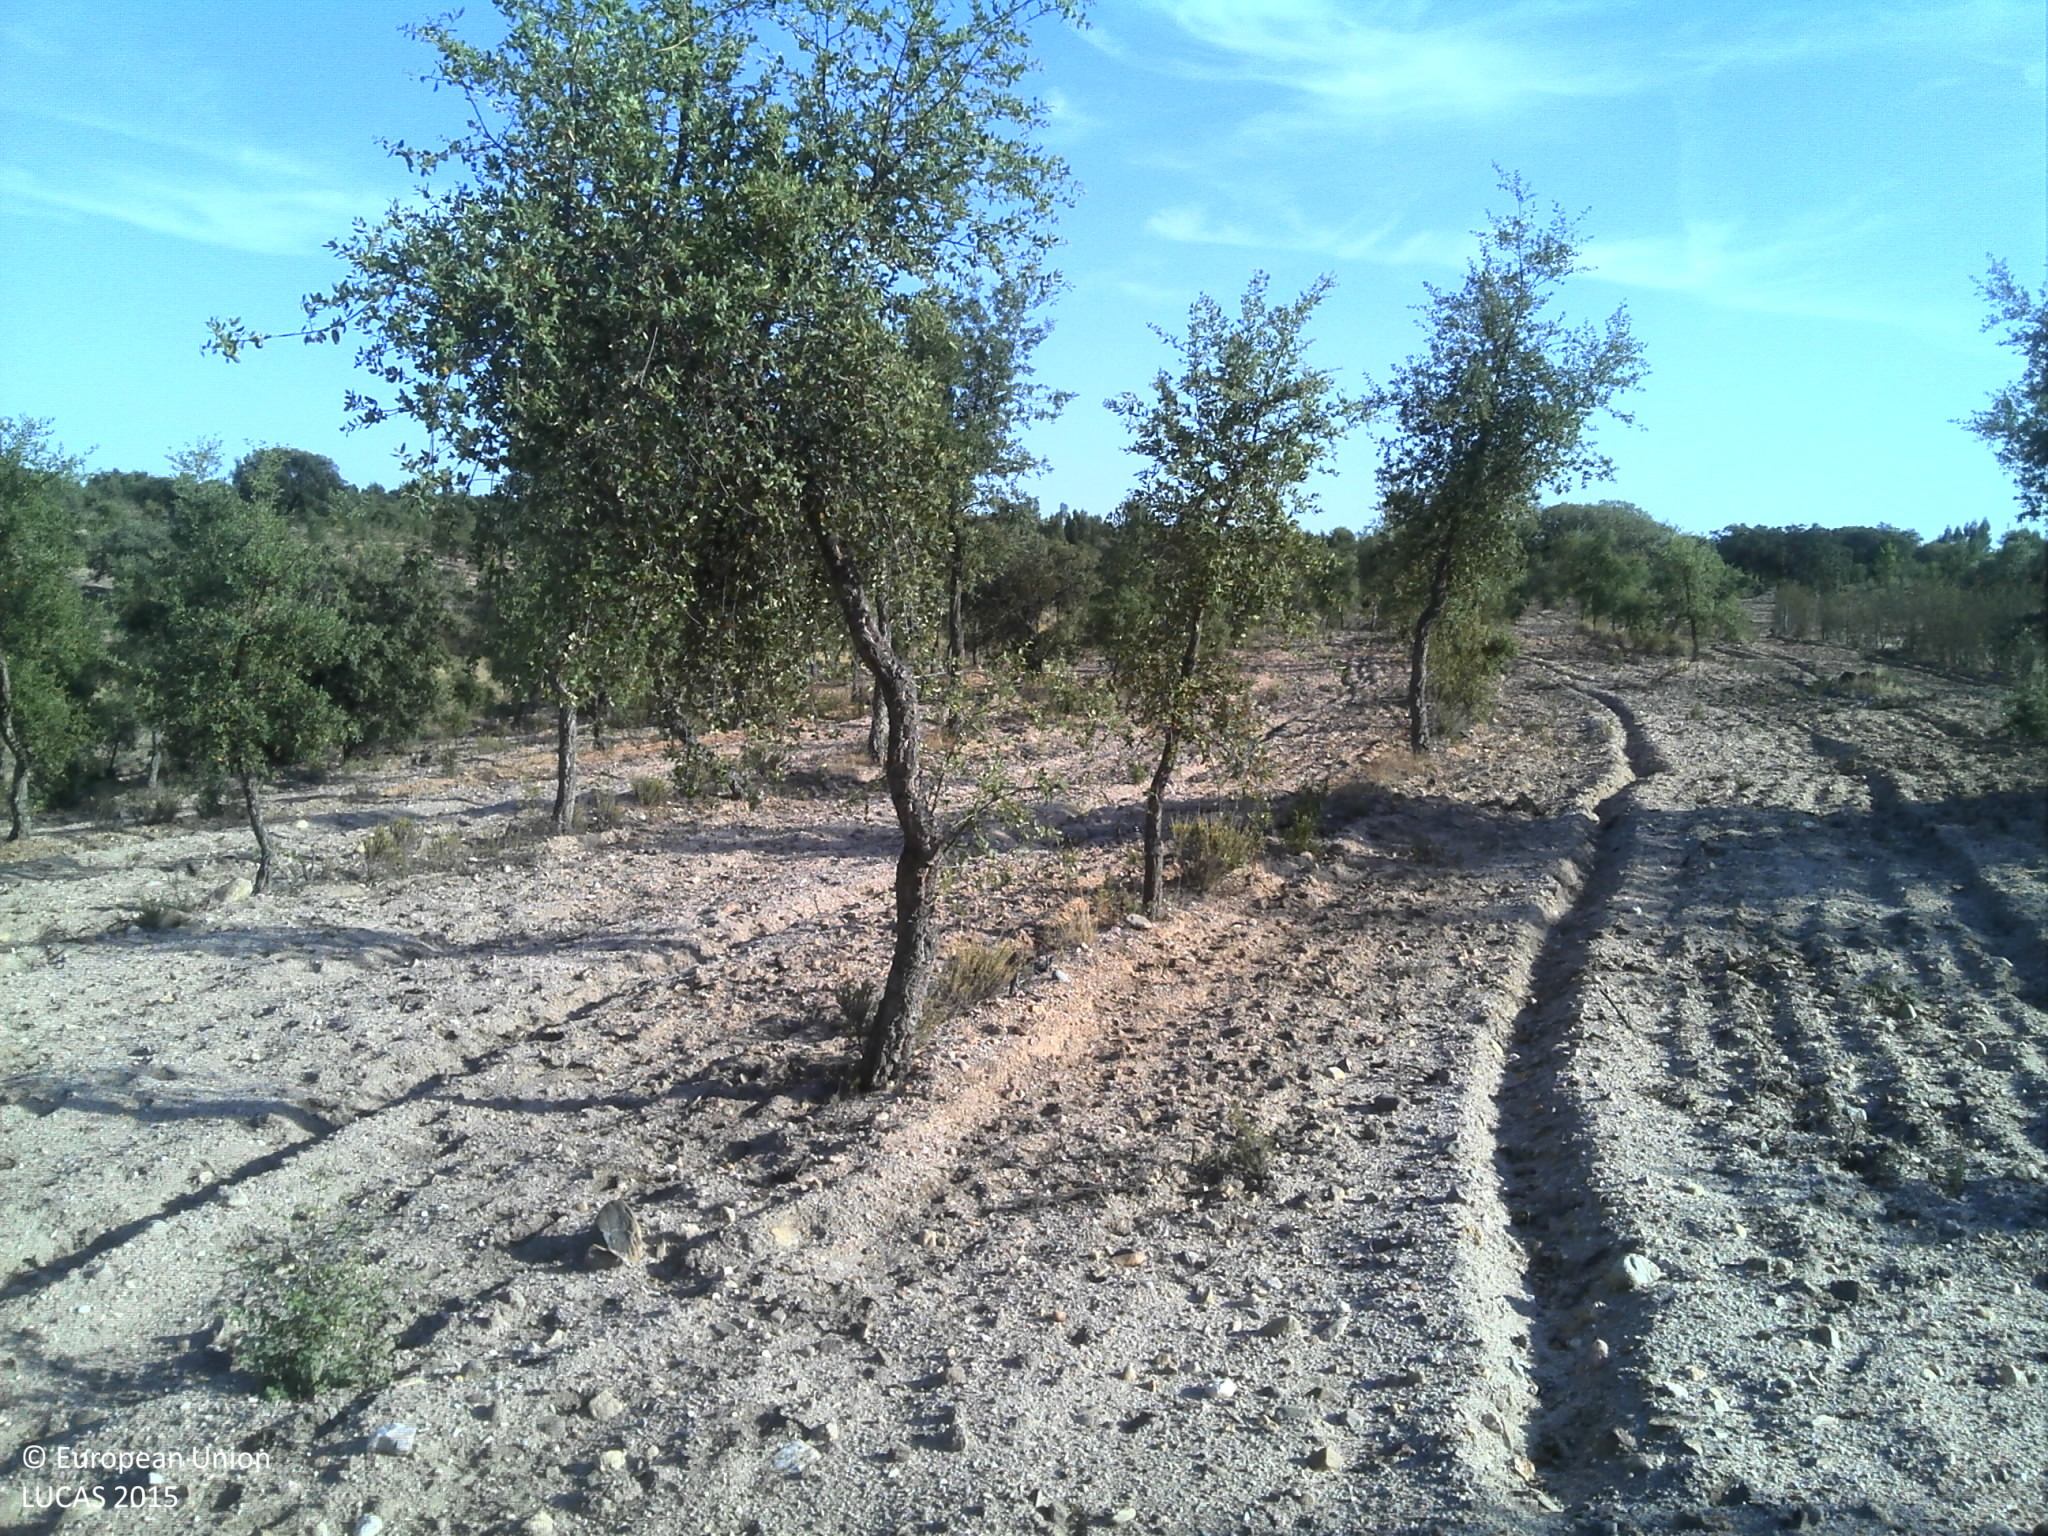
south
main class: Woodland
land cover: Broadleaved woodland
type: broadleaved evergreen forest
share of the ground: 10 - 25 %
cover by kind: unconsolidated bare surface 65 %, broadleaved forest trees 25 %, shrubs 5 %, herbaceous plants 5 %
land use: Forestry
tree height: < 5 m
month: July
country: PT
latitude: 39.7121
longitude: -7.5125
